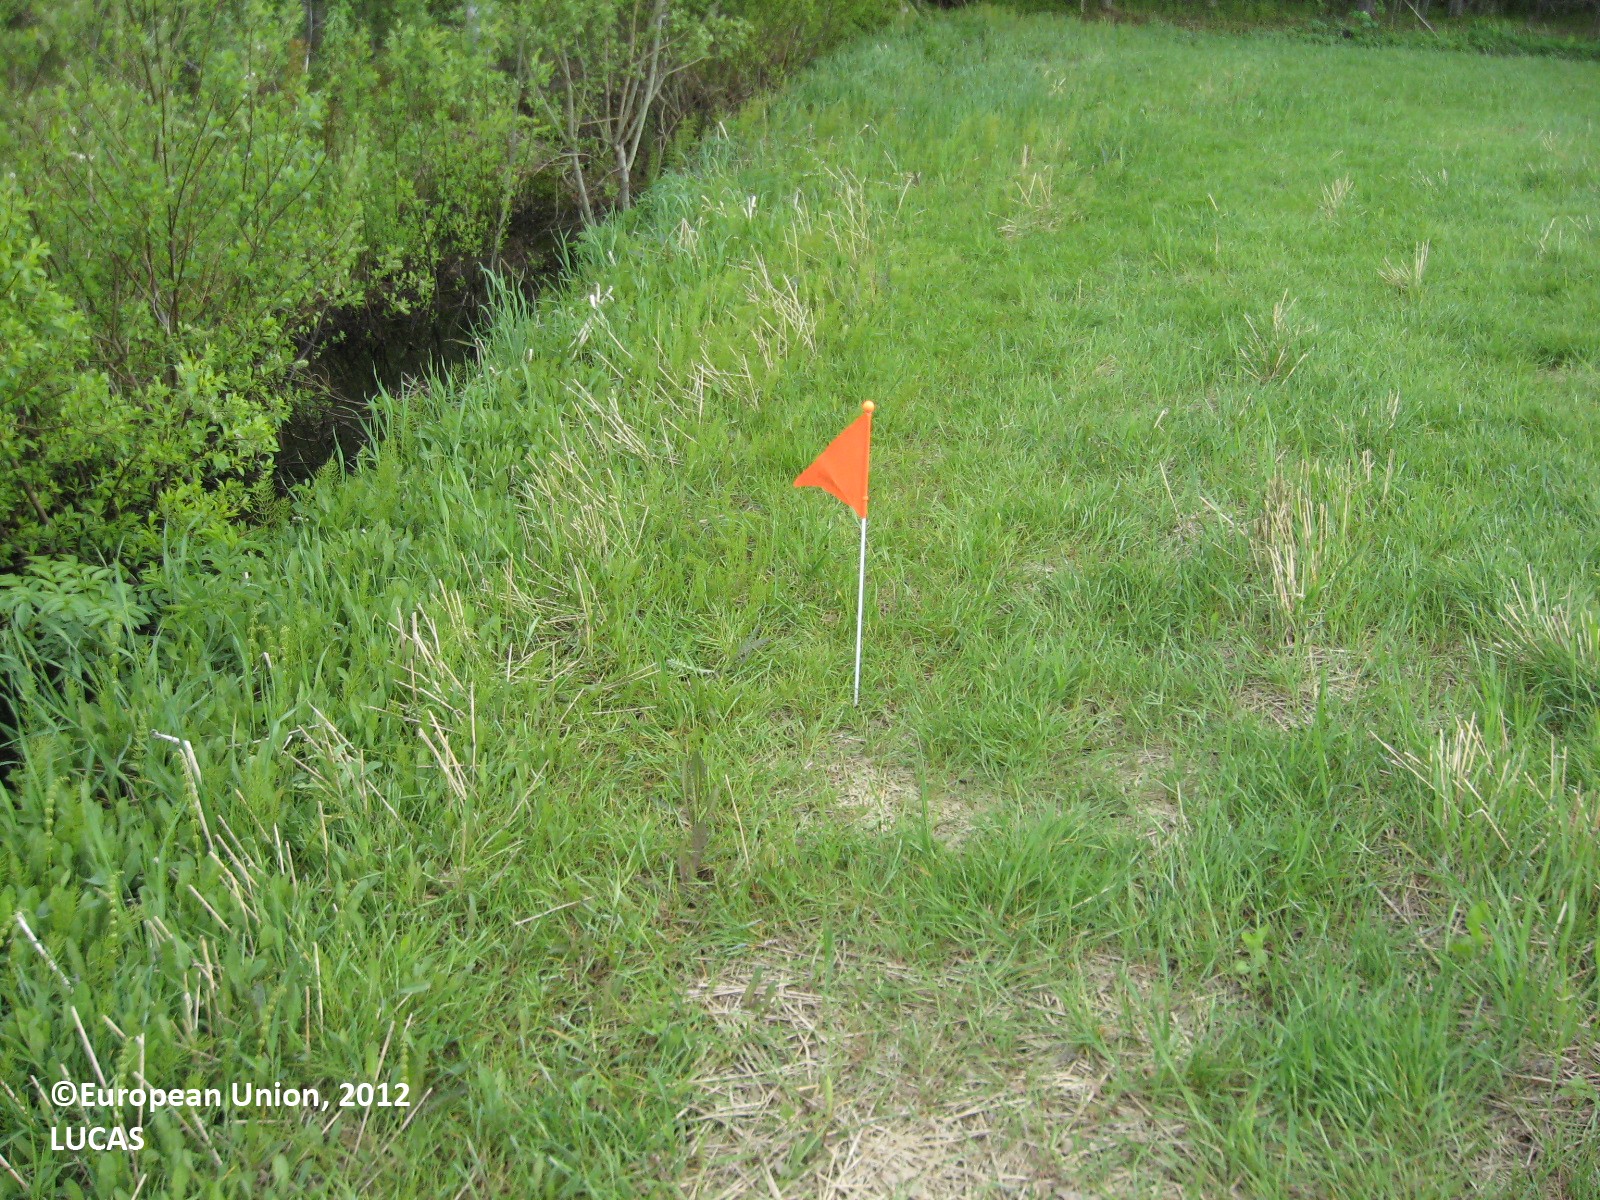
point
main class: Cropland
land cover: Oats
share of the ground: > 75 %
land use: Agriculture (excluding fallow land and kitchen gardens)
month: May
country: FI
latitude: 61.7913
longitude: 22.5596
